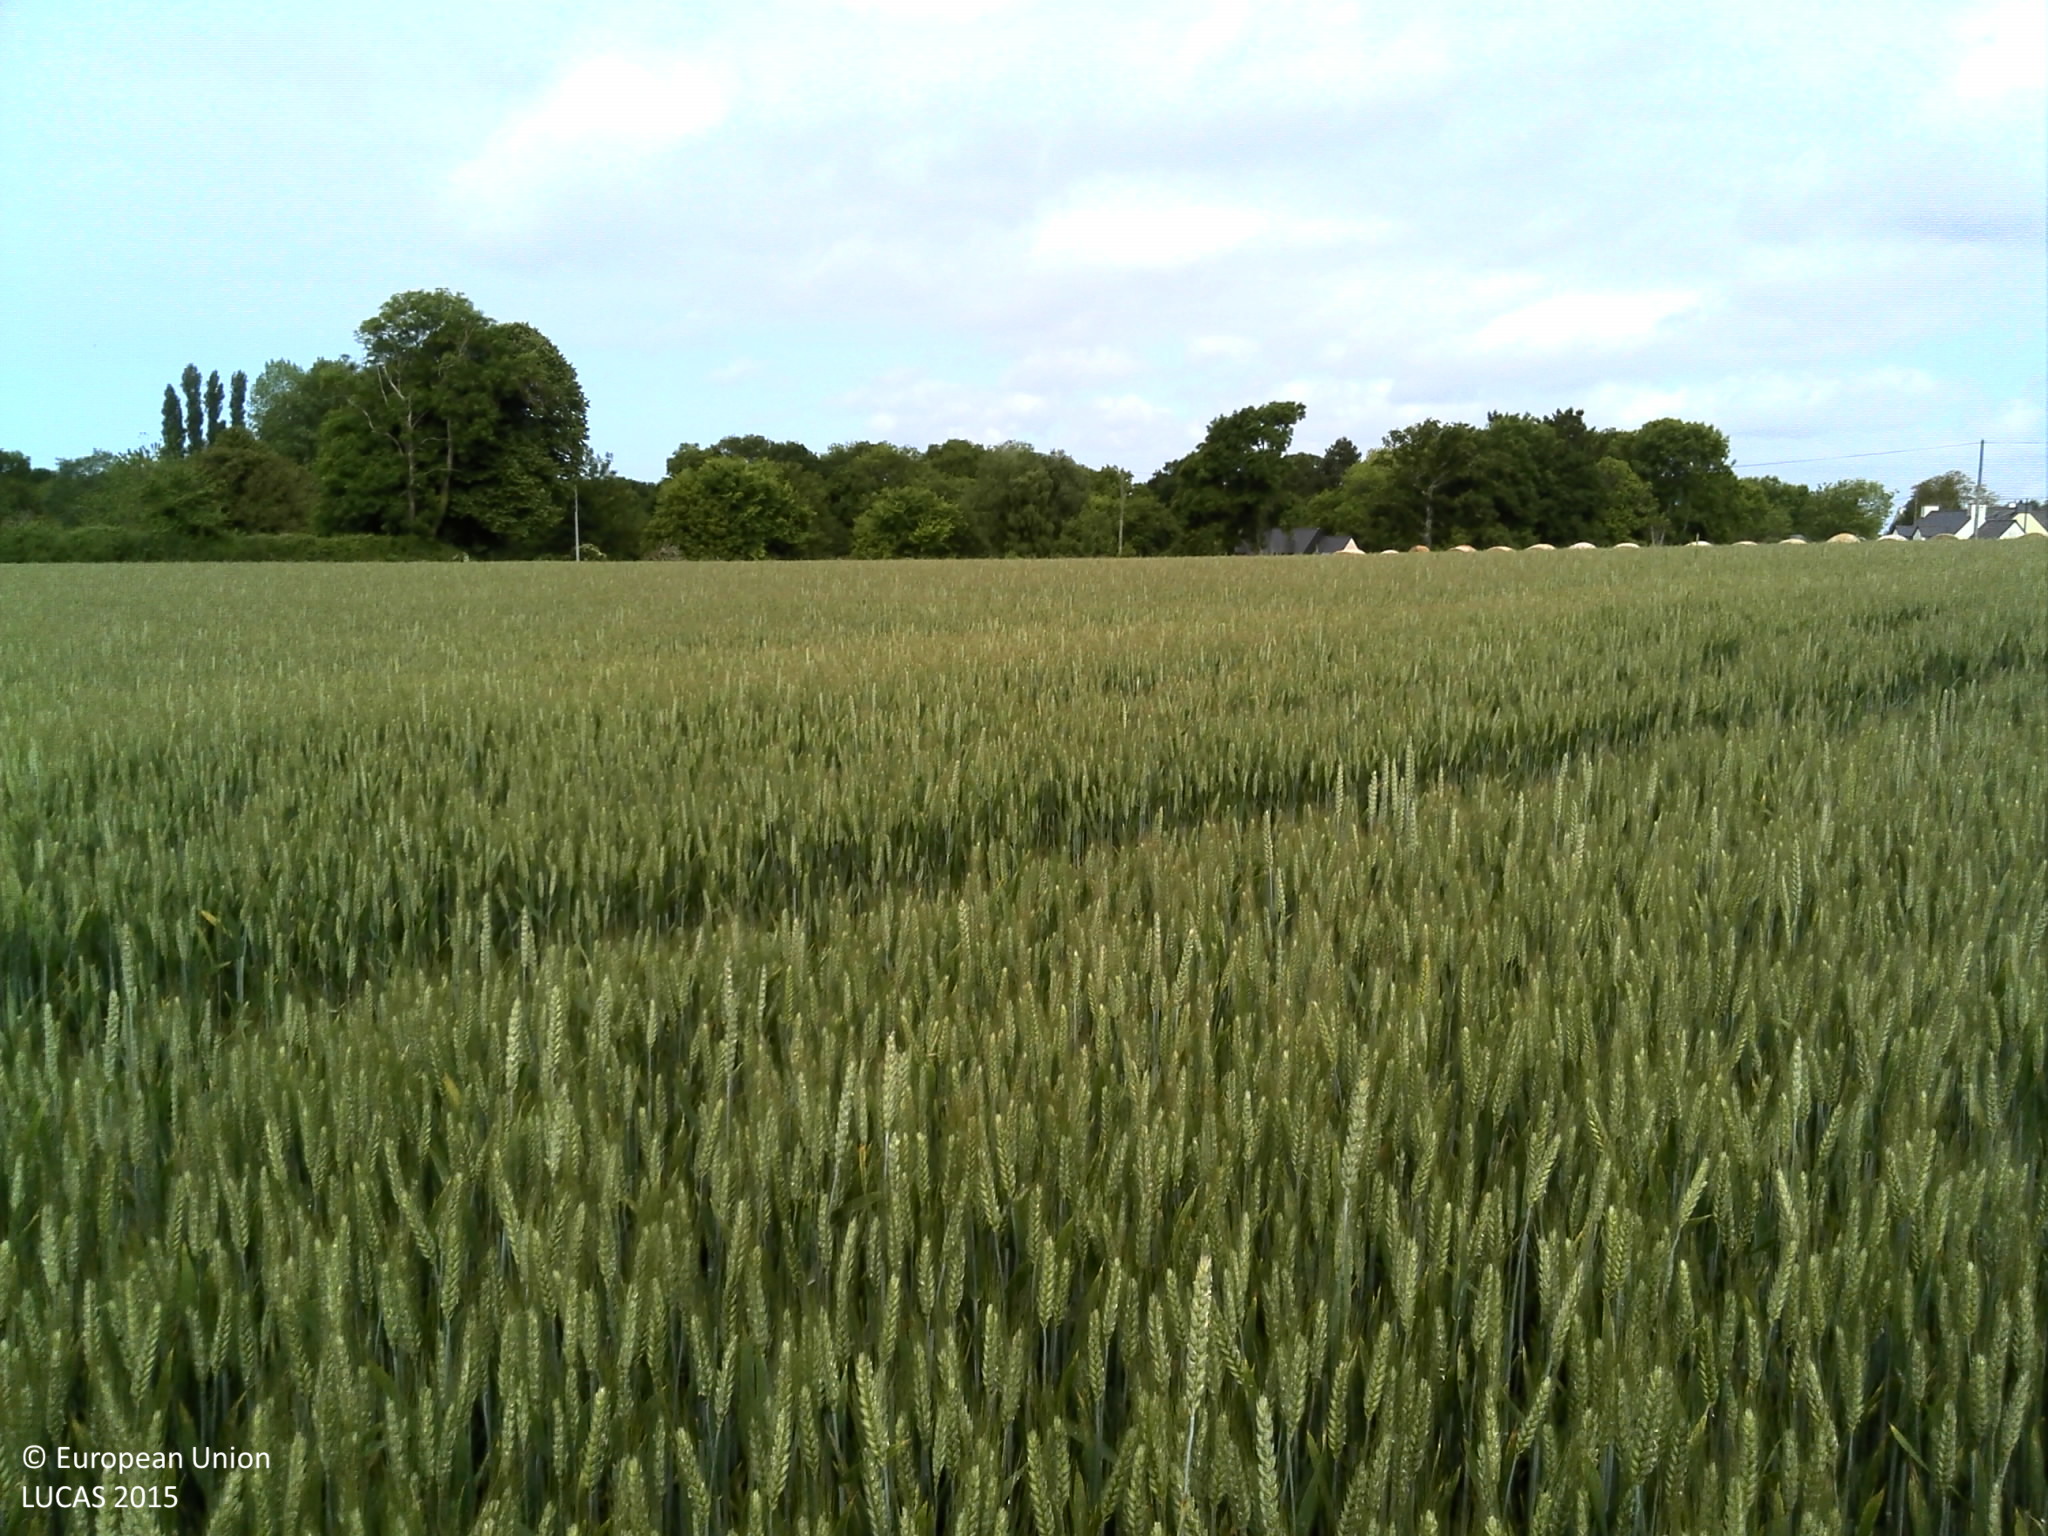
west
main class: Cropland
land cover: Common wheat
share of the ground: > 75 %
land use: Agriculture (excluding fallow land and kitchen gardens)
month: June
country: FR
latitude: 47.7810
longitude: -3.5699
